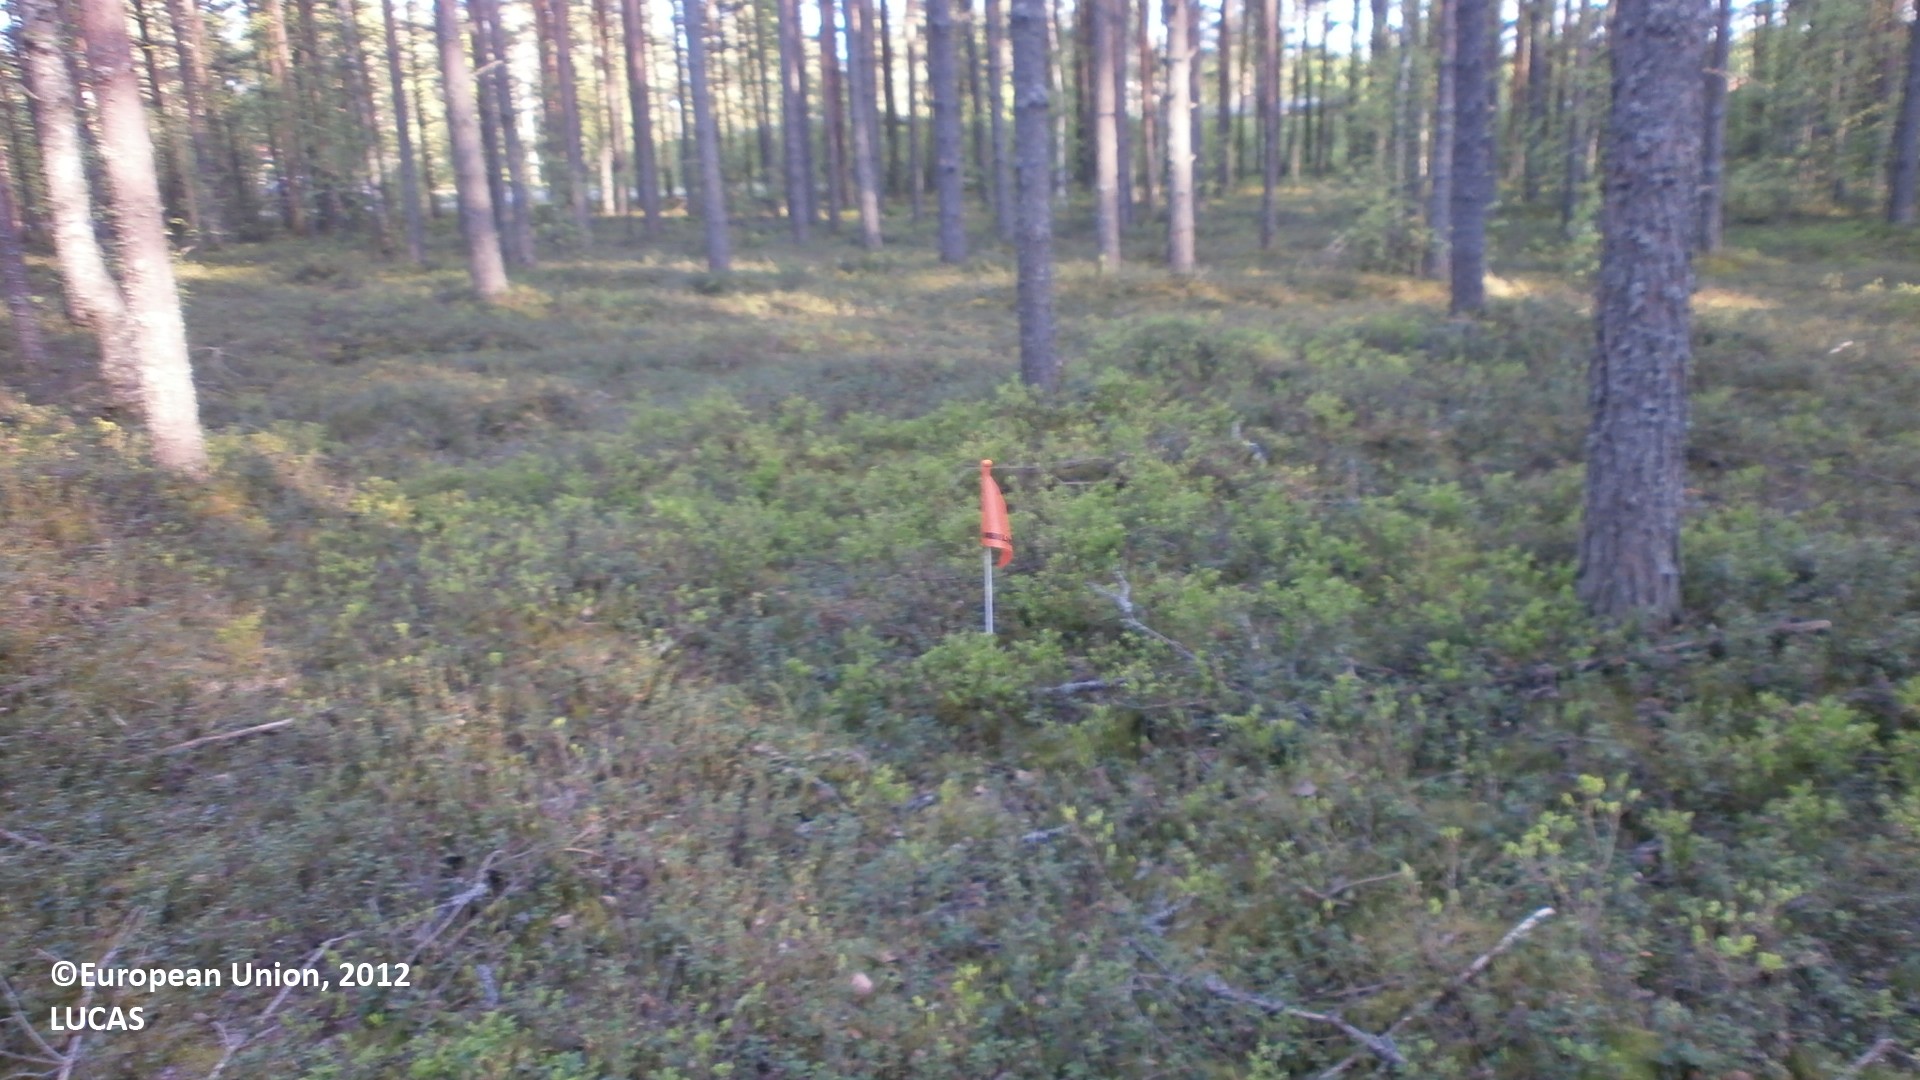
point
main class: Woodland
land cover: Pine dominated coniferous woodland
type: hemiboreal forest and nemoral coniferous forest and mixed broadleaved-coniferous forest
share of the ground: 50 - 75 %
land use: Semi-natural and natural areas not in use
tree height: > 5 m
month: June
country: FI
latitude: 64.4915
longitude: 25.0014
